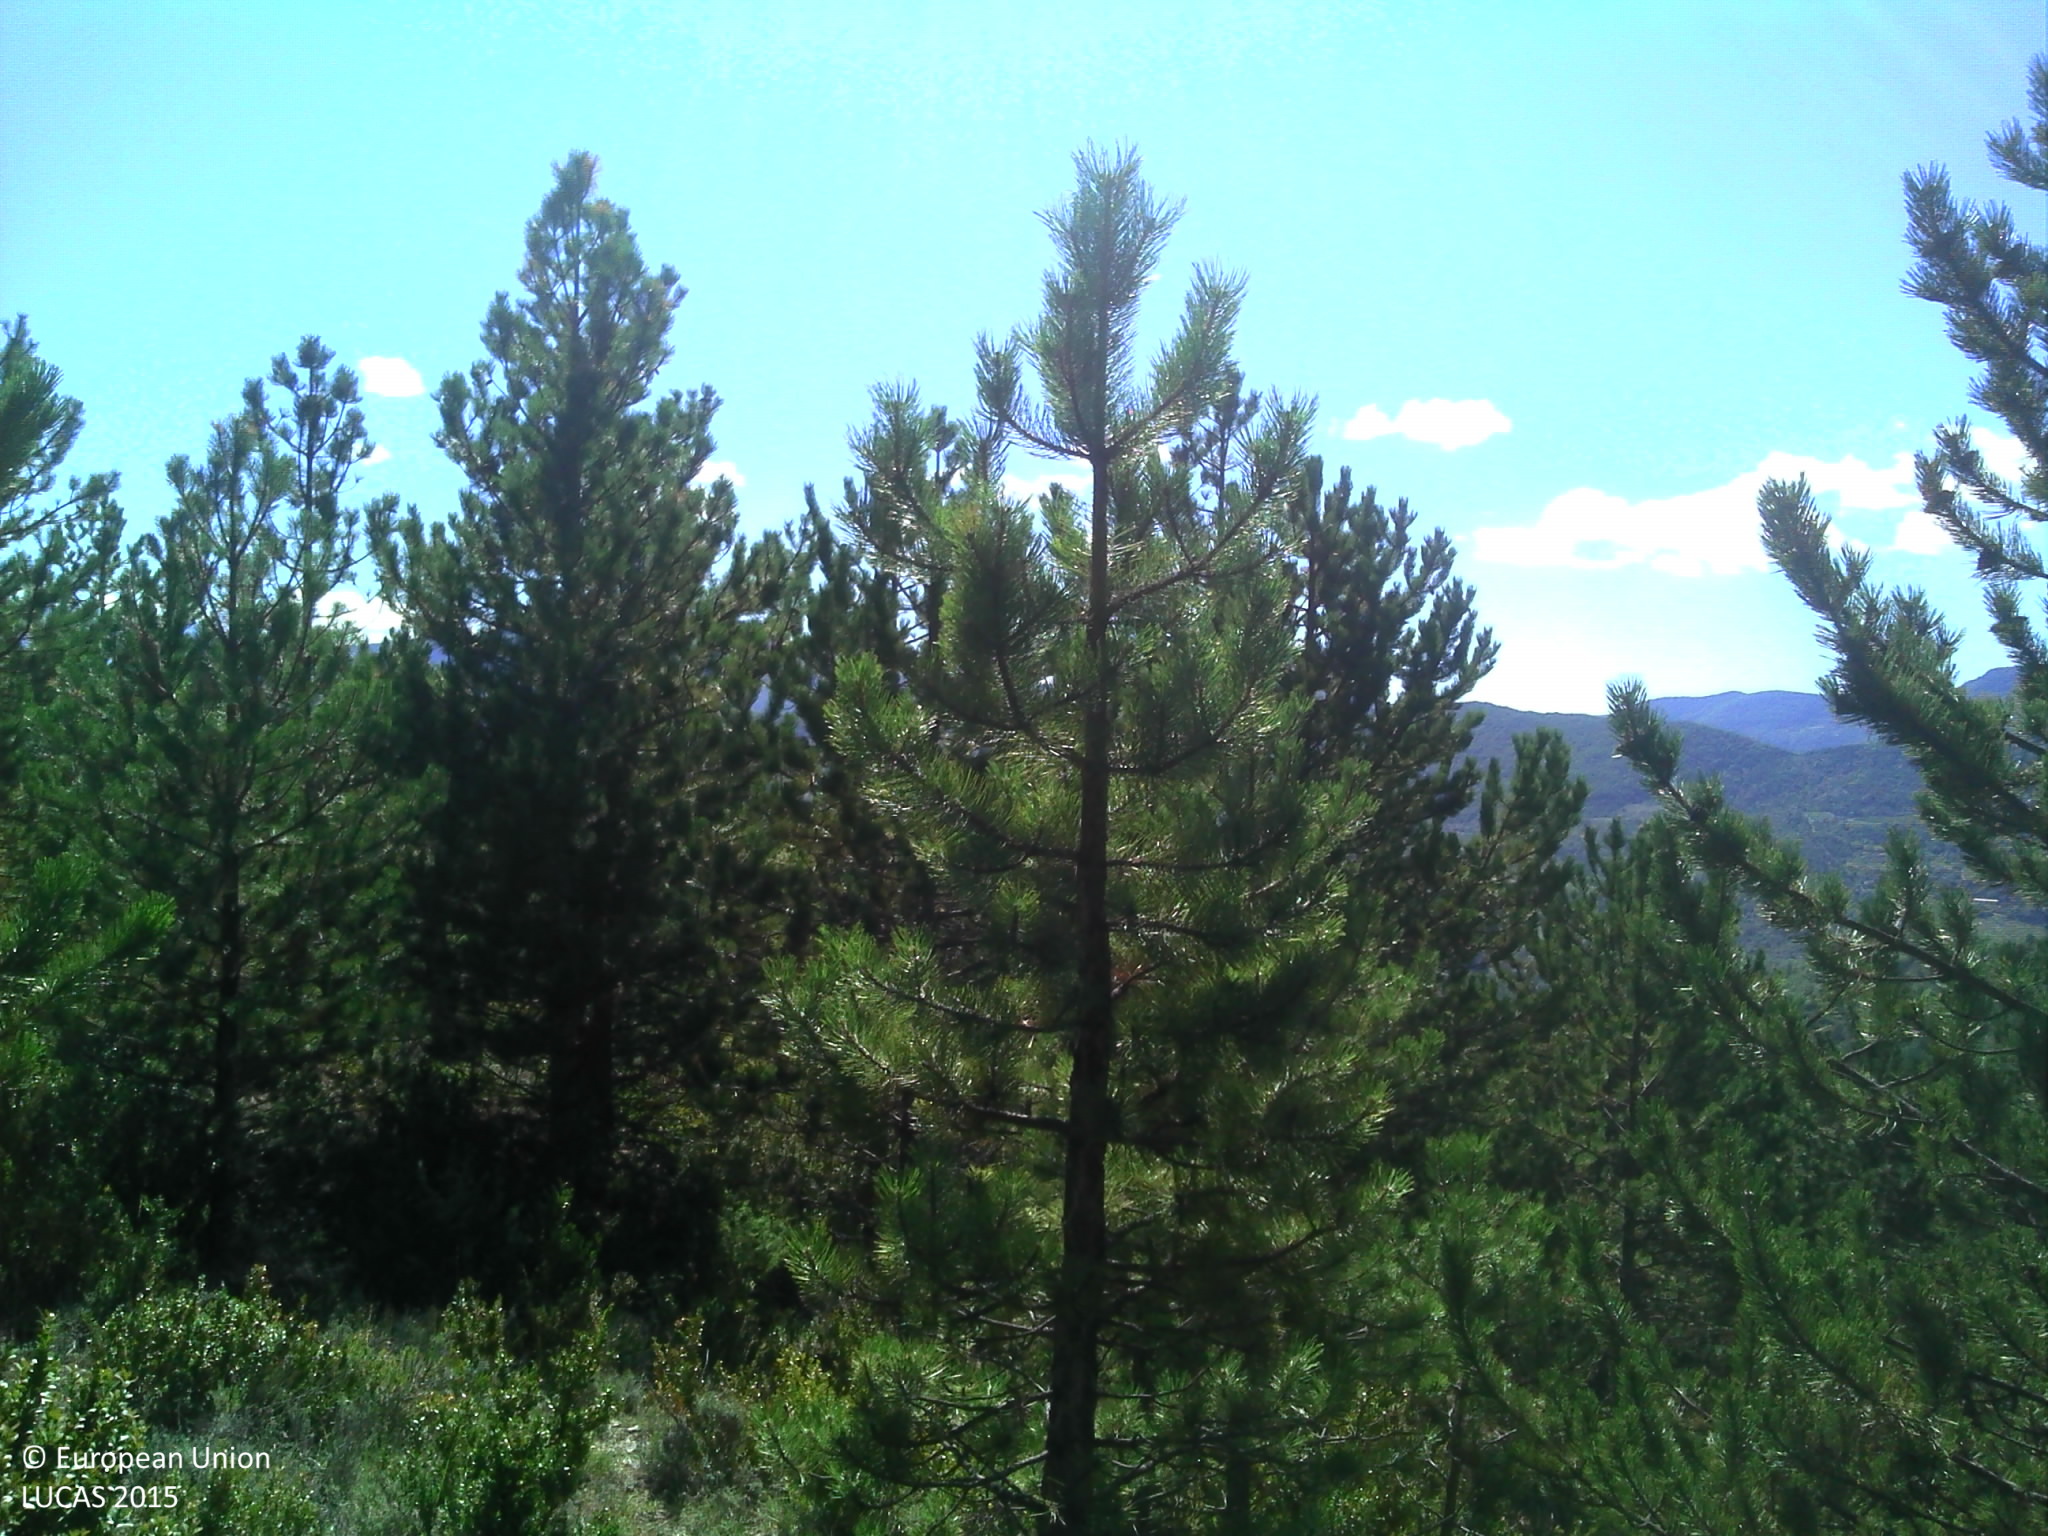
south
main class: Woodland
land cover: Pine dominated coniferous woodland
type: coniferous forest of the mediterranean region
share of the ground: > 75 %
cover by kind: coniferous forest trees 95 %, broadleaved forest trees 5 %
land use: Forestry
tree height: > 5 m
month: September
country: FR
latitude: 44.3875
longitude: 5.2749
